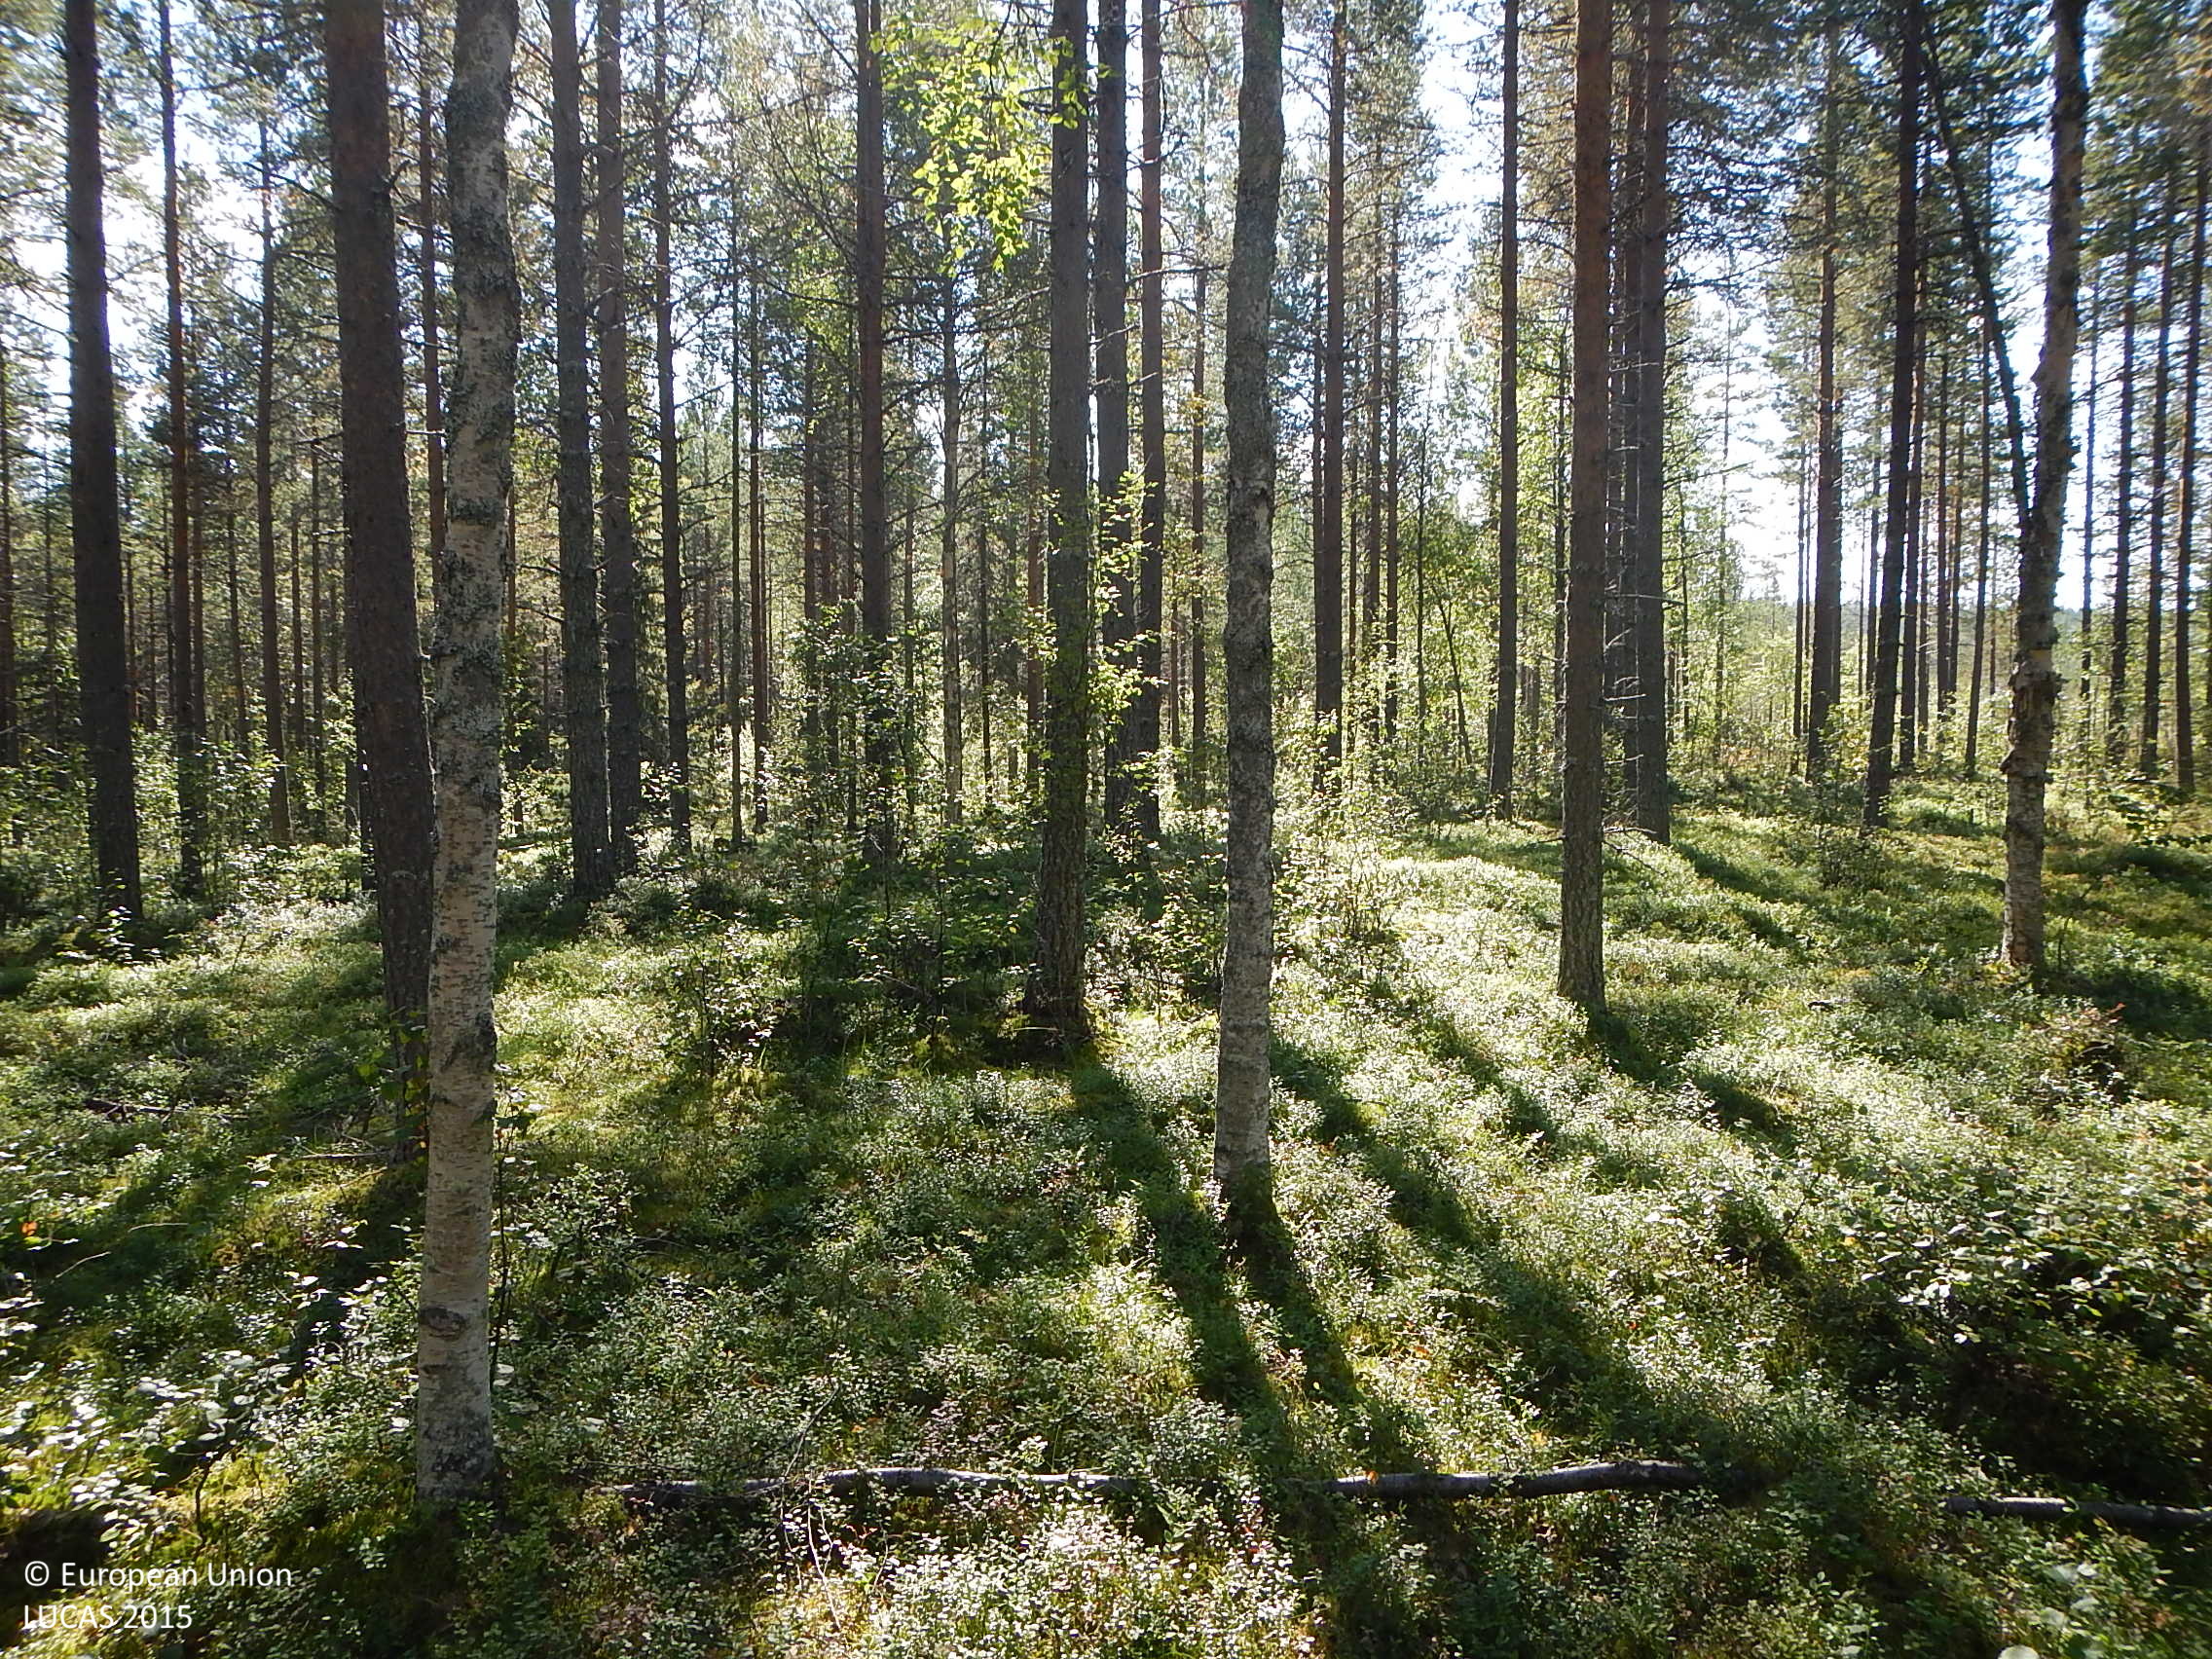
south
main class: Woodland
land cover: Pine dominated coniferous woodland
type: boreal forest
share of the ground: > 75 %
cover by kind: coniferous forest trees 65 %, shrubs 20 %, broadleaved forest trees 10 %, lichens and mosses 5 %
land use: Forestry
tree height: > 5 m
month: August
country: FI
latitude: 66.4675
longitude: 28.3902
